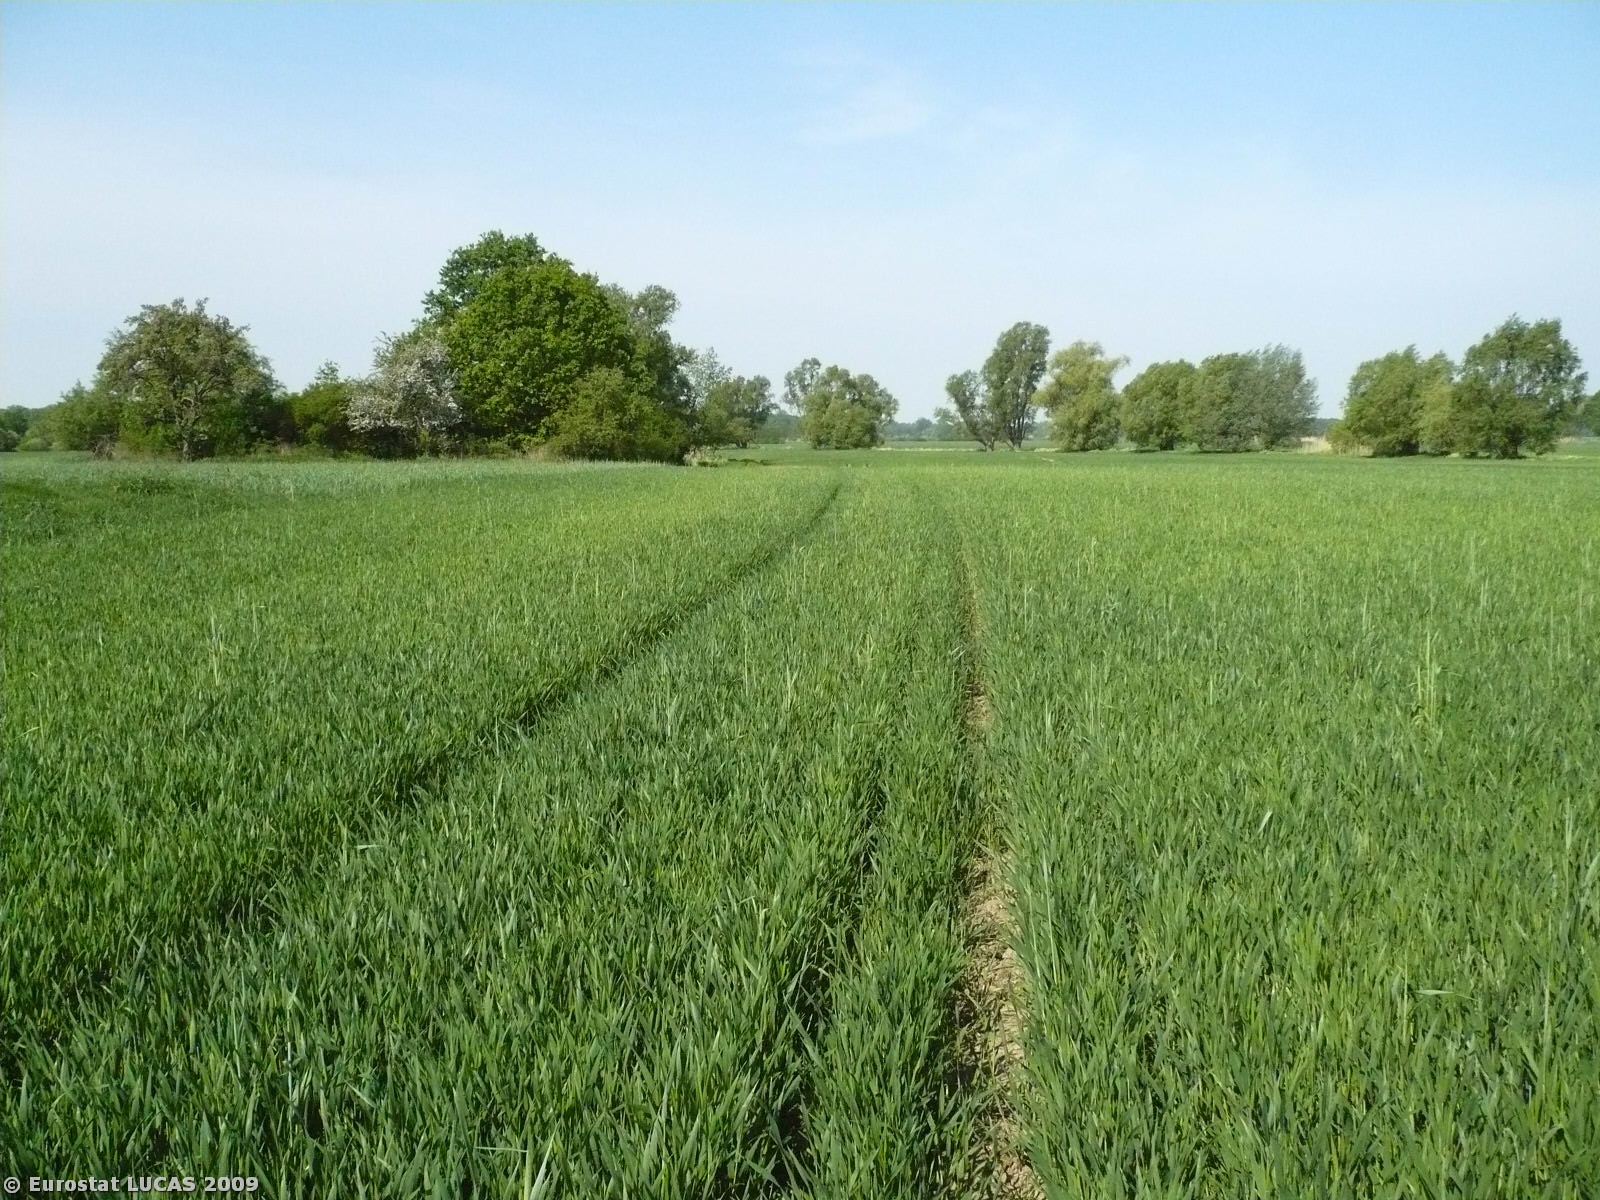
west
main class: Cropland
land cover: Common wheat
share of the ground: > 75 %
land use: Agriculture (excluding fallow land and kitchen gardens)
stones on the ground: < 10 %
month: May
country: PL
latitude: 52.0077
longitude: 15.6717
